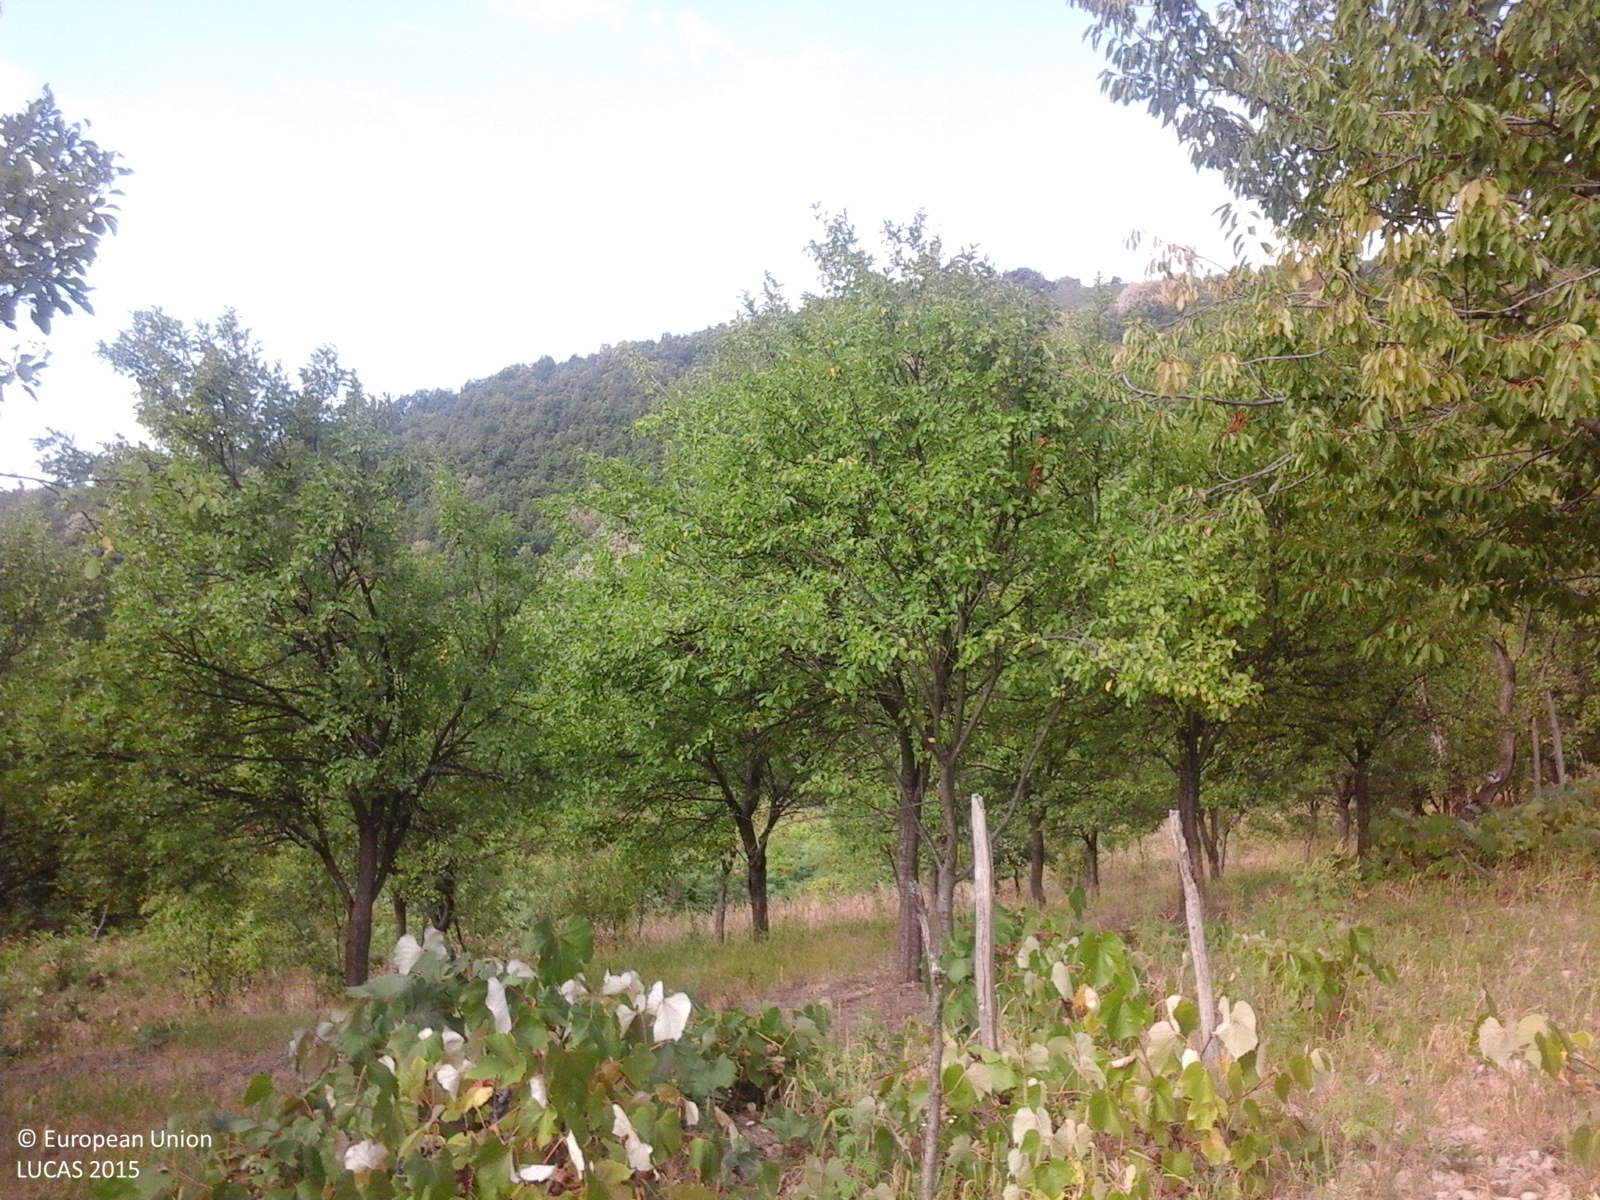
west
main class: Cropland
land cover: Vineyards
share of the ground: > 75 %
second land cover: Grassland without tree/shrub cover
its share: < 10 %
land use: Agriculture (excluding fallow land and kitchen gardens)
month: September
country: RO
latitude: 47.9357
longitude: 23.2026
